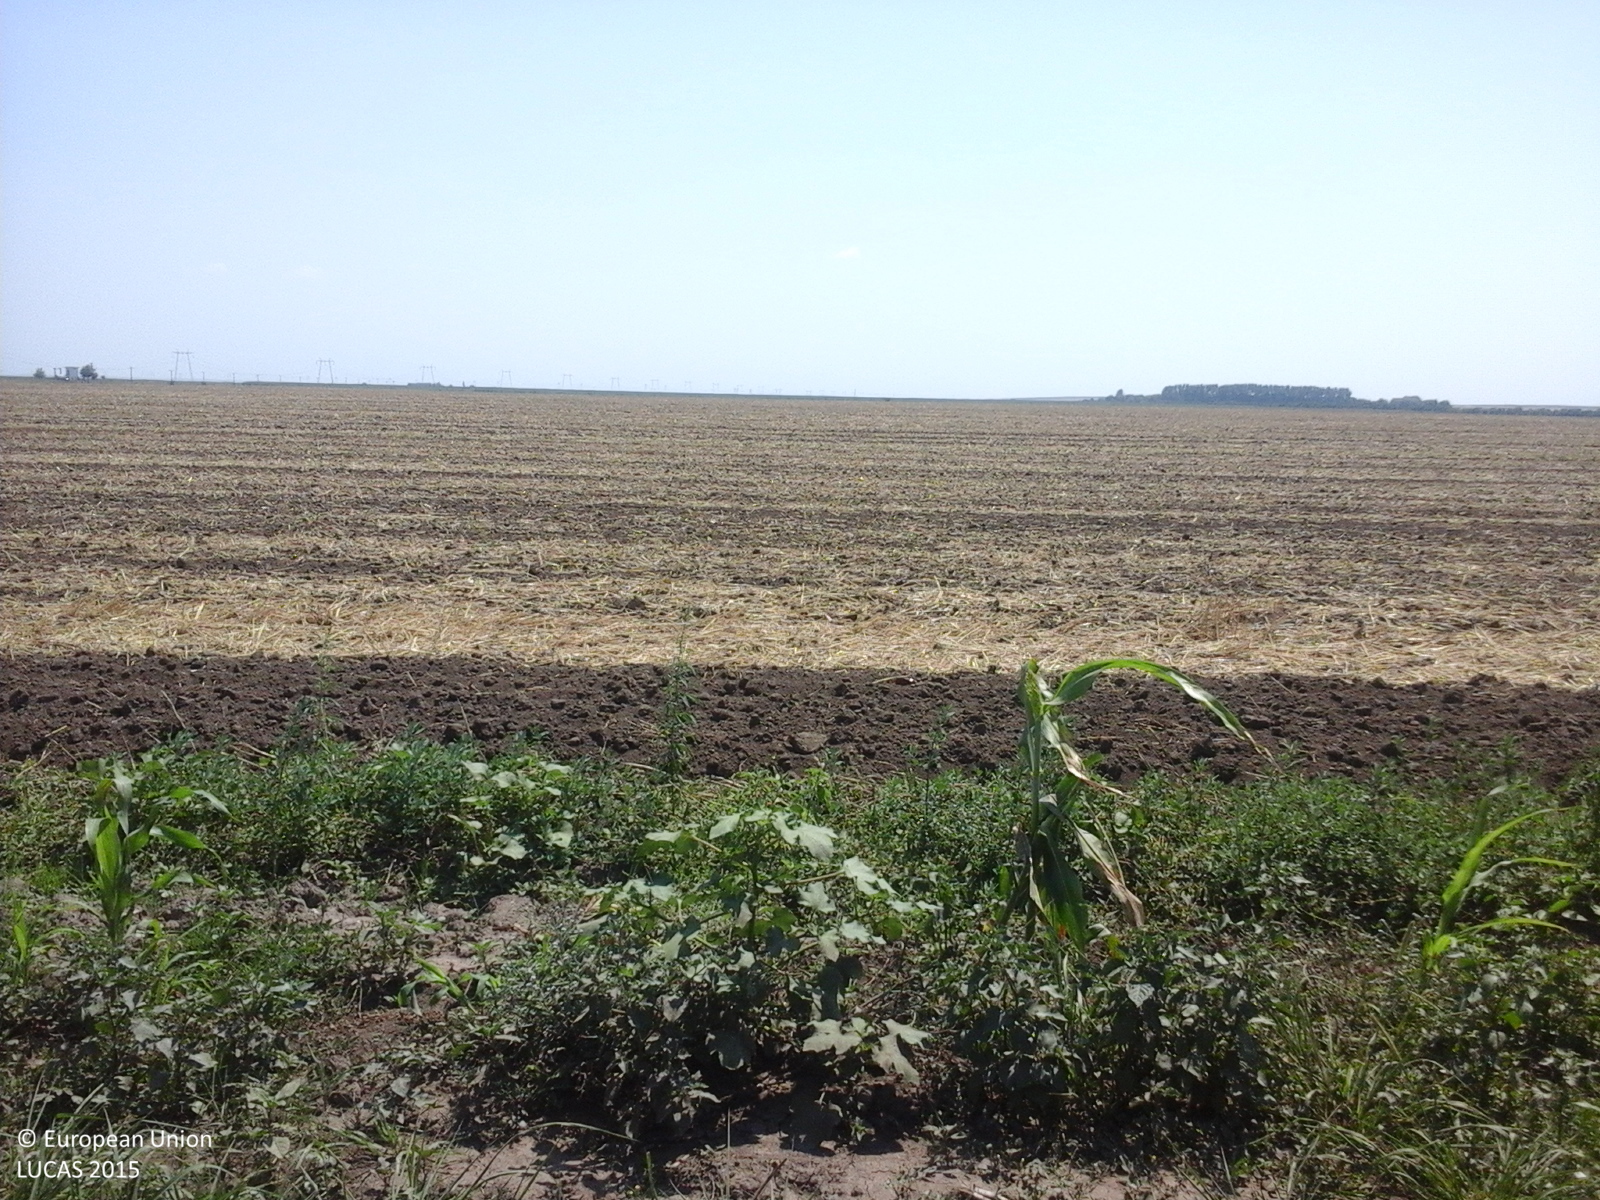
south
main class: Cropland
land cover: Other fresh vegetables
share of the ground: > 75 %
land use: Agriculture (excluding fallow land and kitchen gardens)
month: July
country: RO
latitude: 44.7584
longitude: 27.6467
